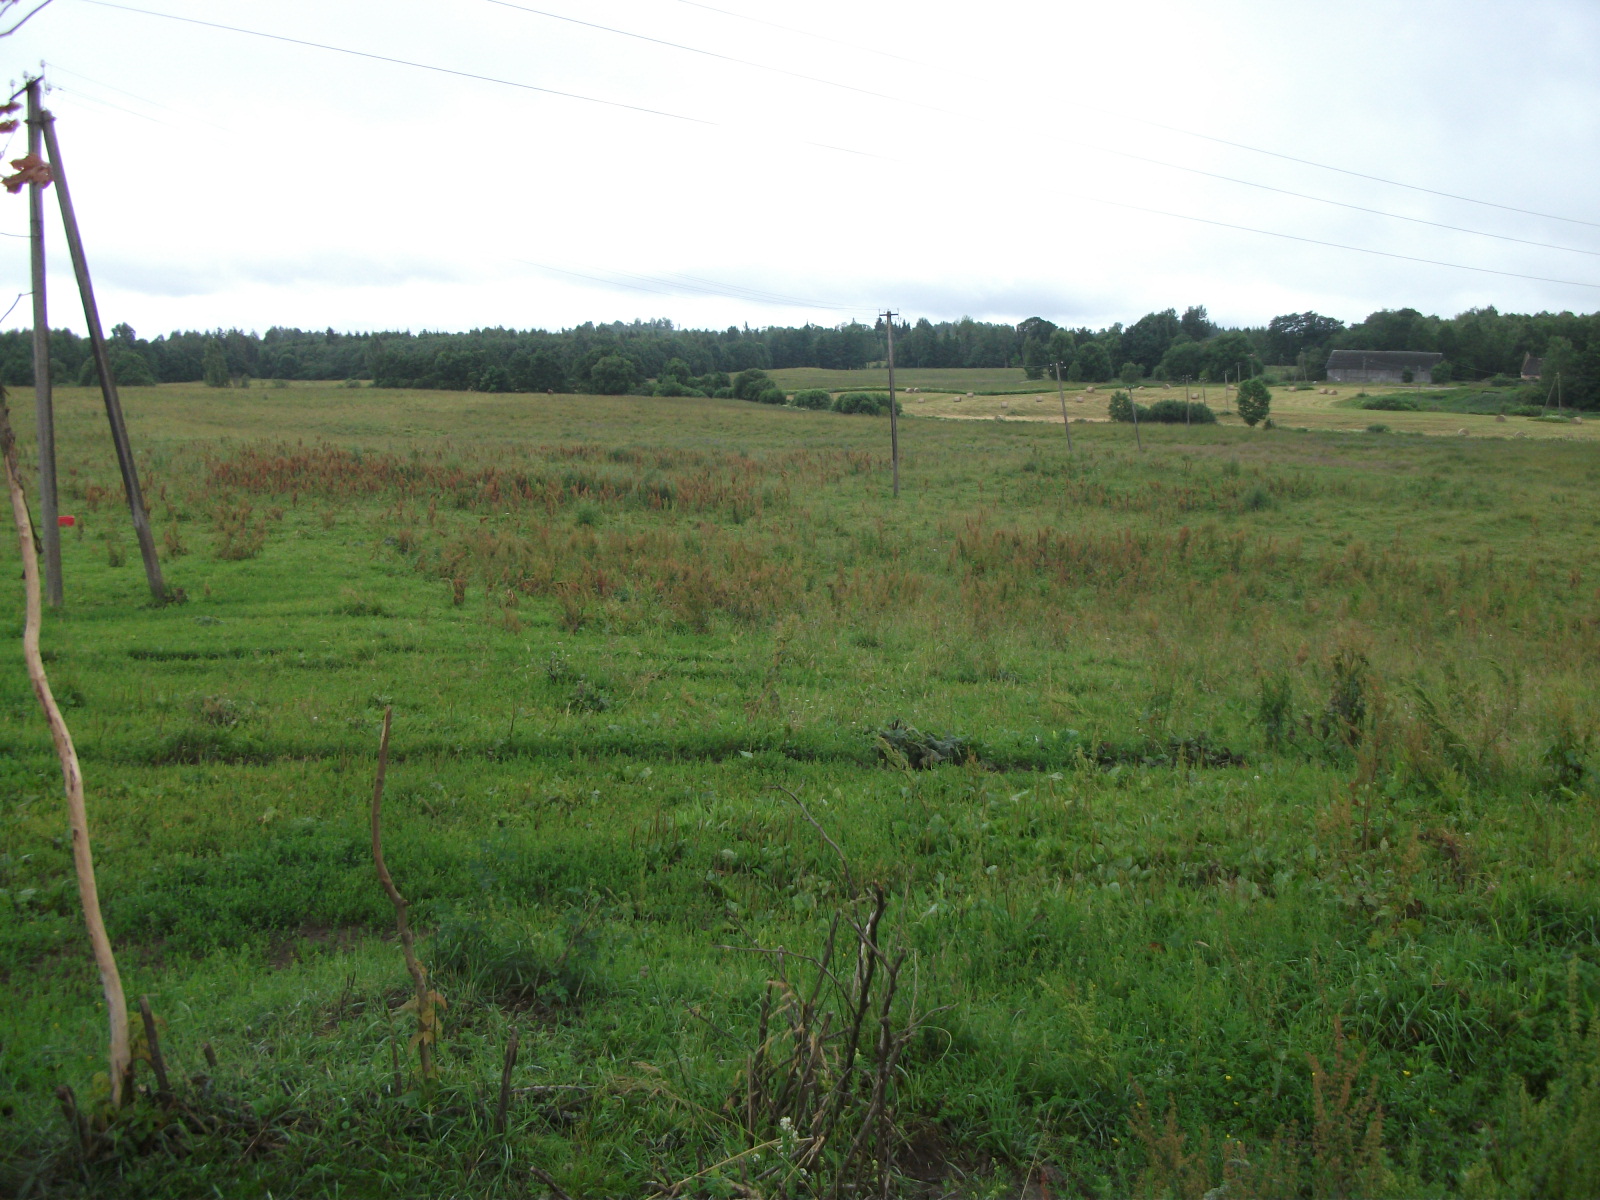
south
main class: Grassland
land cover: Grassland without tree/shrub cover
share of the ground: > 75 %
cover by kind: herbaceous plants 100 %
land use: Agriculture (excluding fallow land and kitchen gardens)
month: July
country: LV
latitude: 56.9598
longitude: 26.2714
